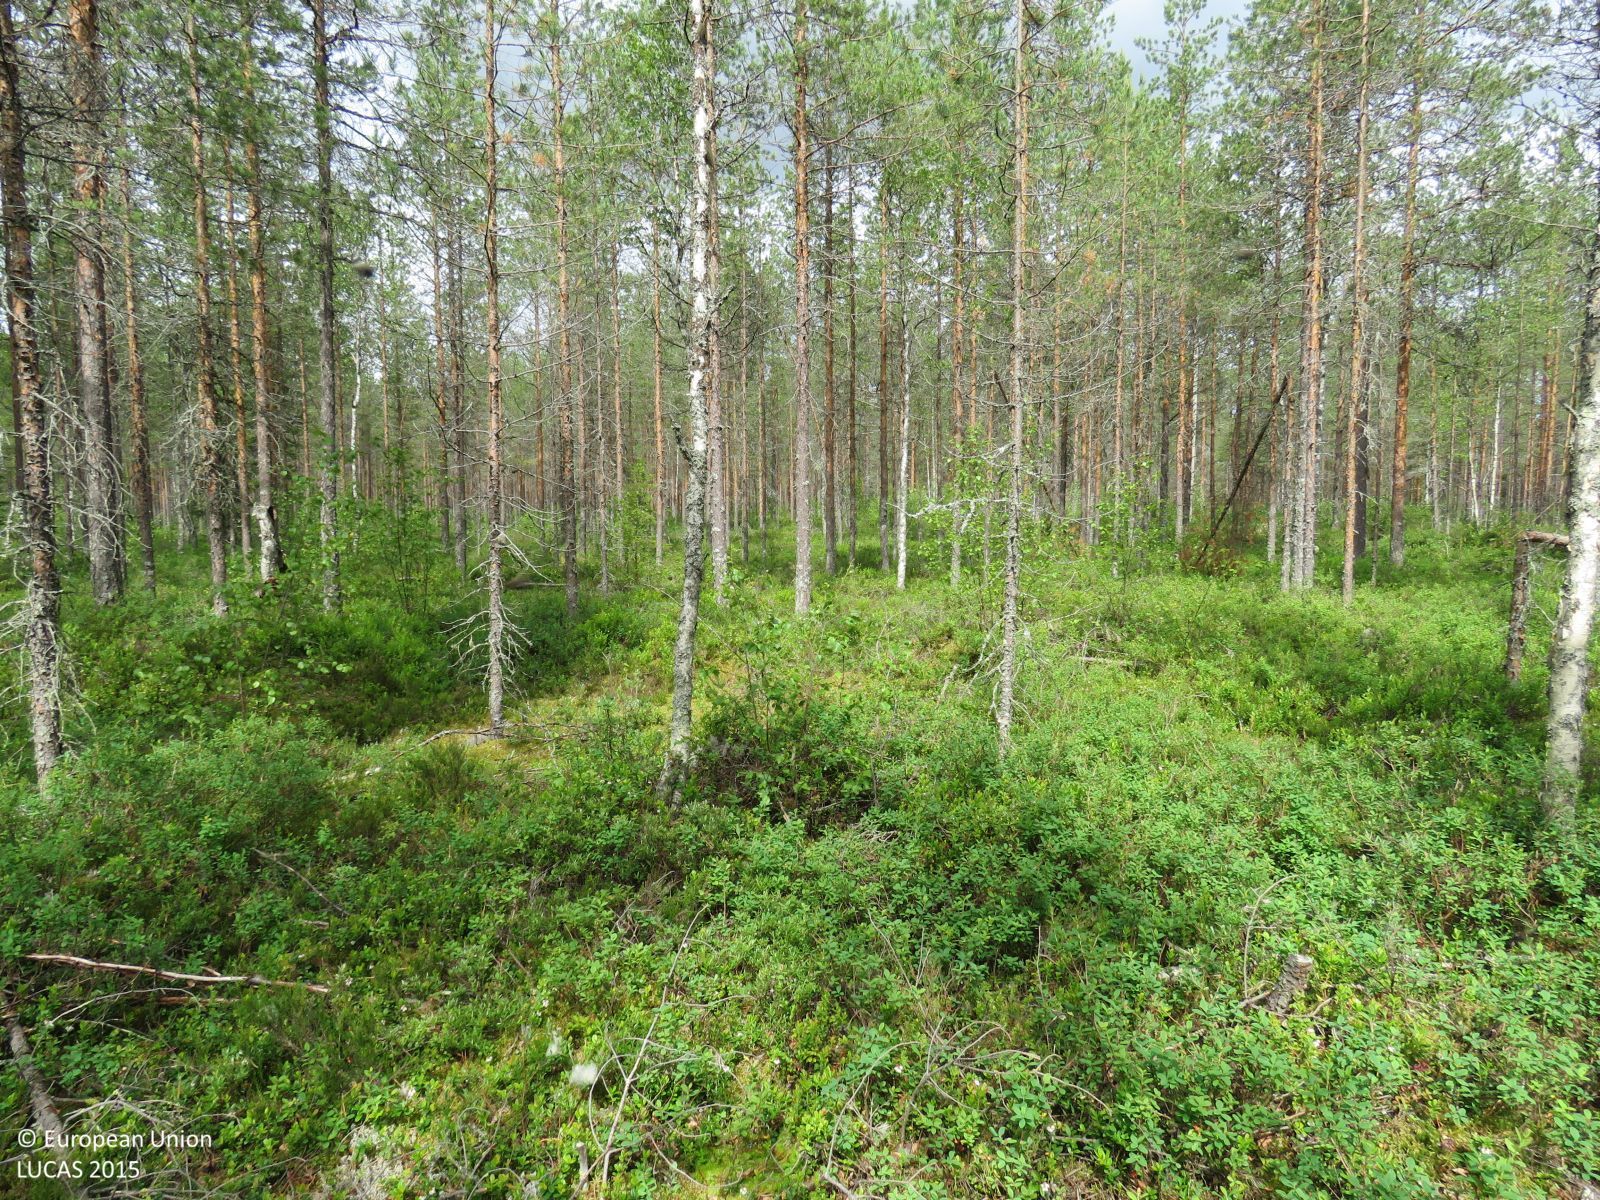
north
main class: Woodland
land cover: Pine dominated coniferous woodland
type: boreal forest
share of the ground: 50 - 75 %
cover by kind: coniferous forest trees 50 %, shrubs 25 %, broadleaved forest trees 10 %, lichens and mosses 10 %, herbaceous plants 5 %
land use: Forestry
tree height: > 5 m
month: July
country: FI
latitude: 64.4469
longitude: 26.5522
